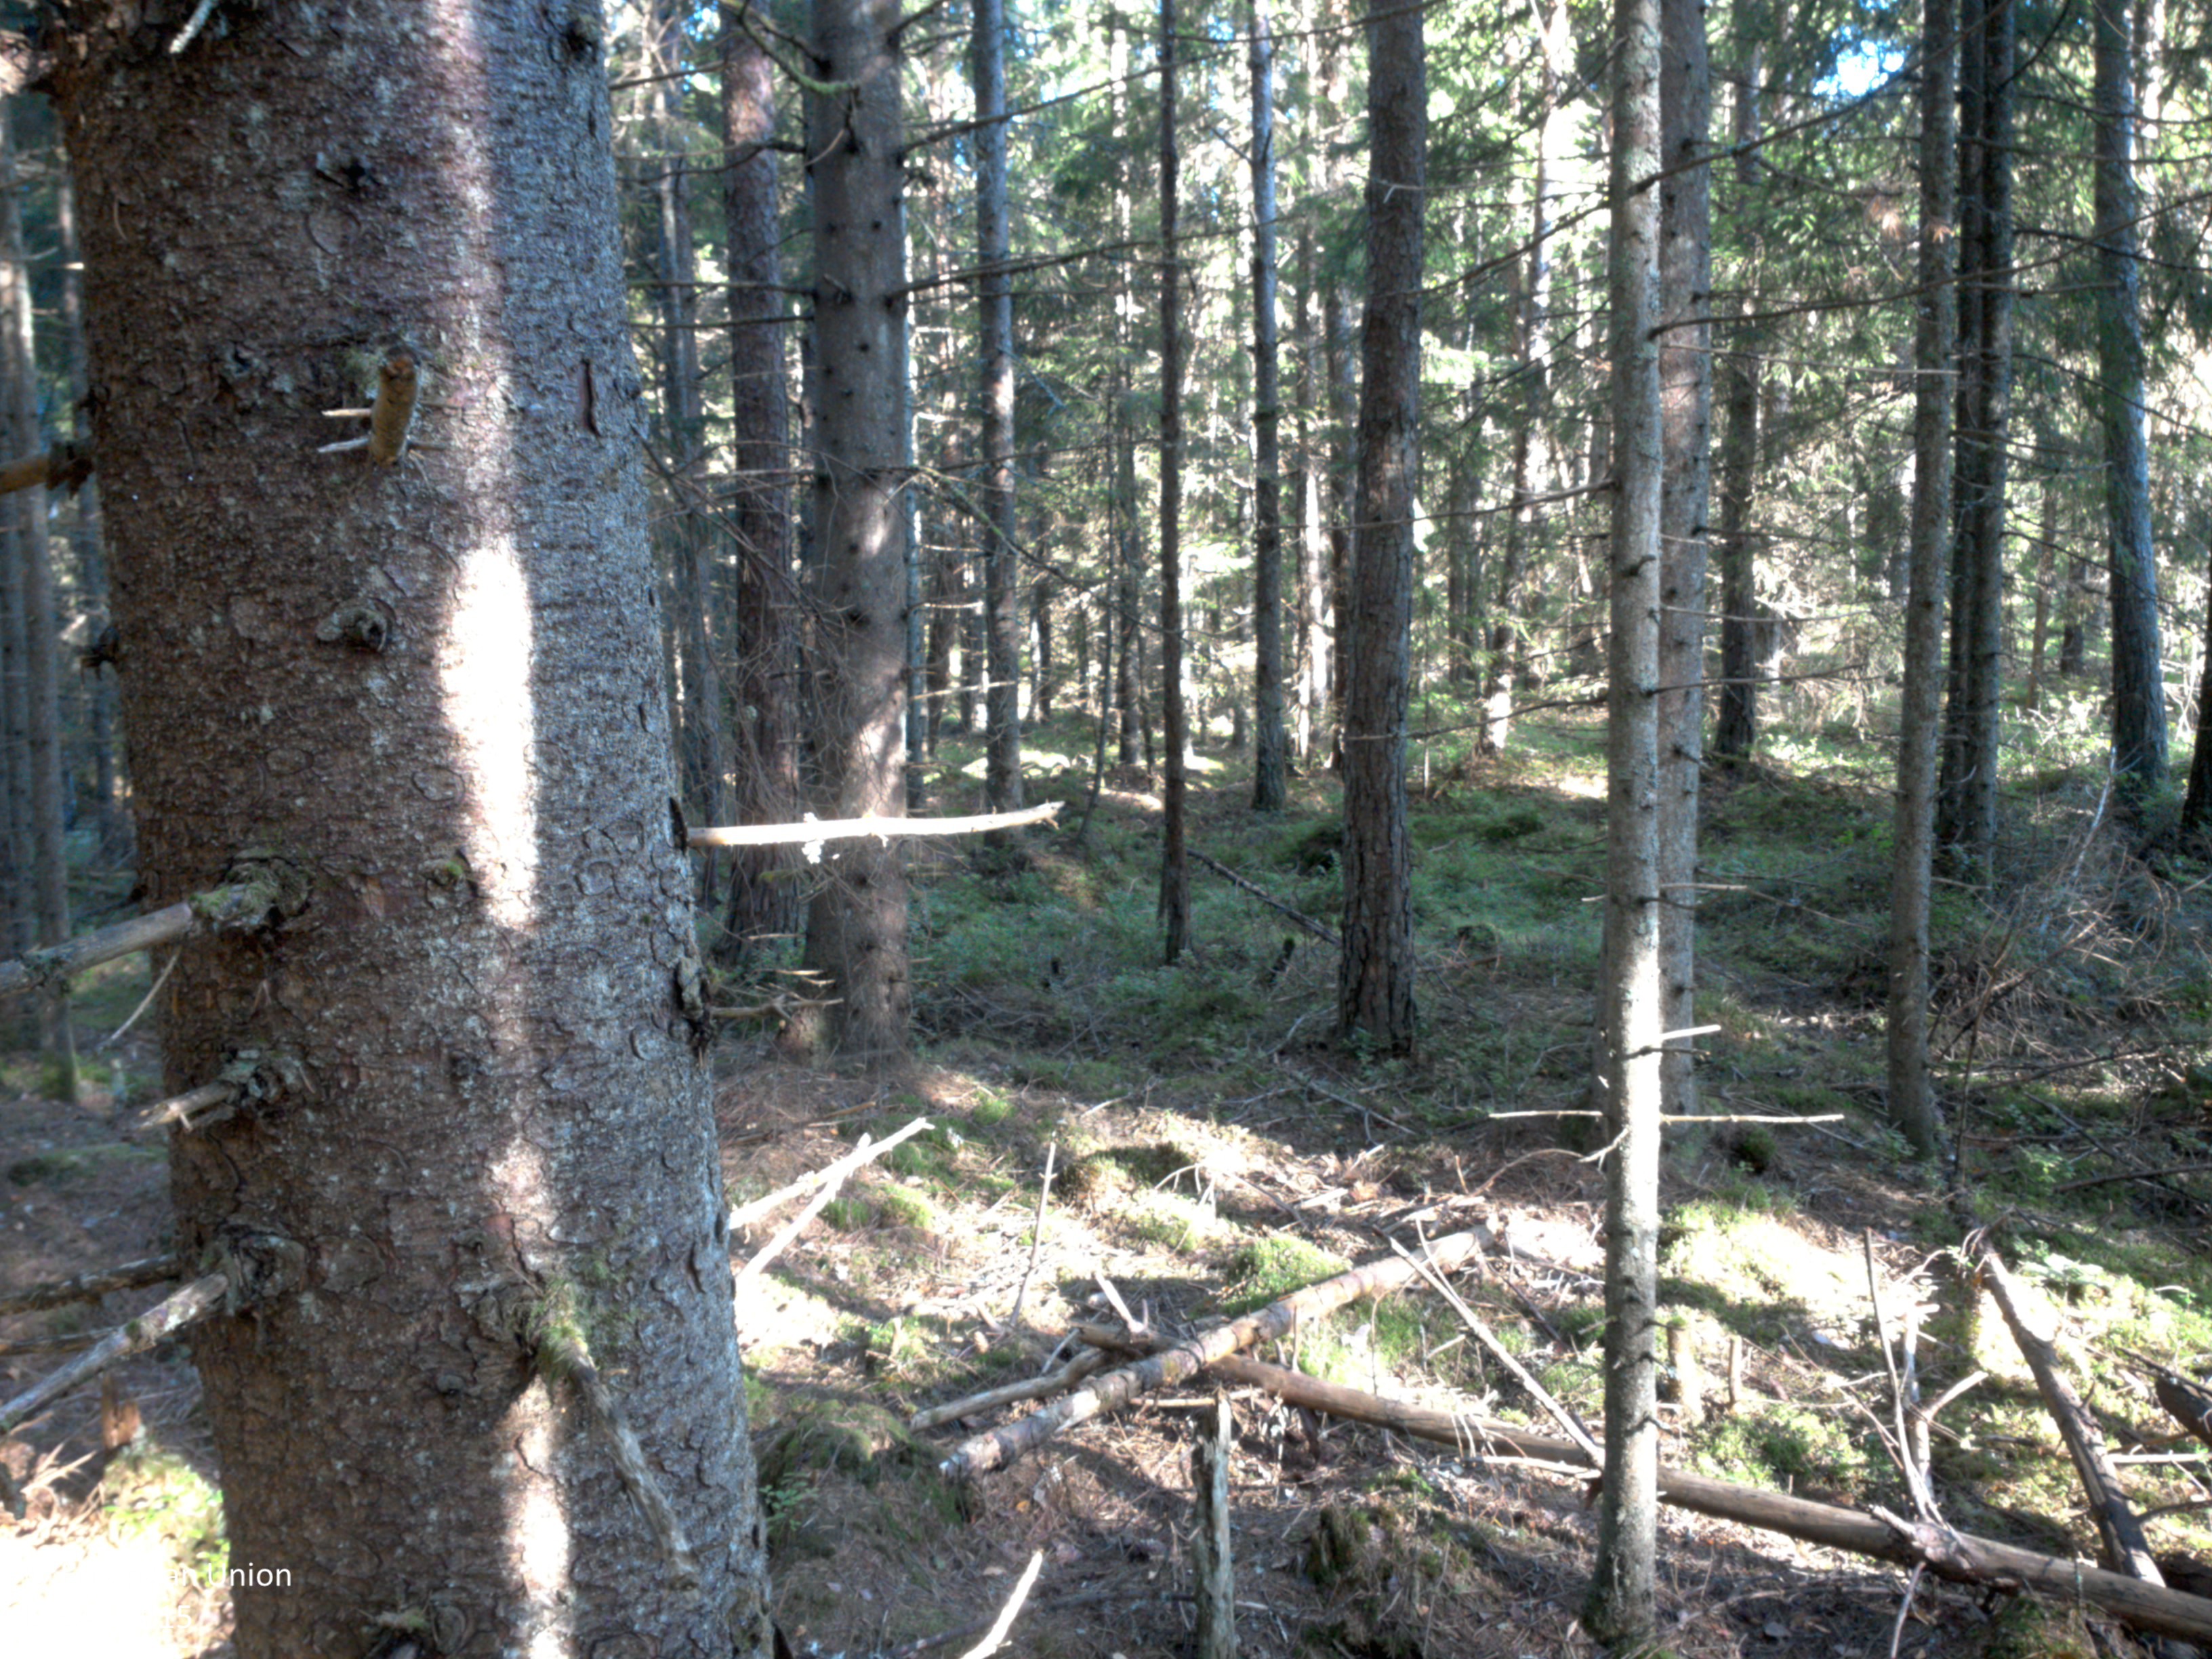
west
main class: Woodland
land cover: Spruce dominated coniferous woodland
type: boreal forest
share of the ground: 50 - 75 %
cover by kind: coniferous forest trees 60 %, shrubs 15 %, lichens and mosses 15 %, herbaceous plants 10 %
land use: Forestry
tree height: > 5 m
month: August
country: SE
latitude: 58.5426
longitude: 12.2460
